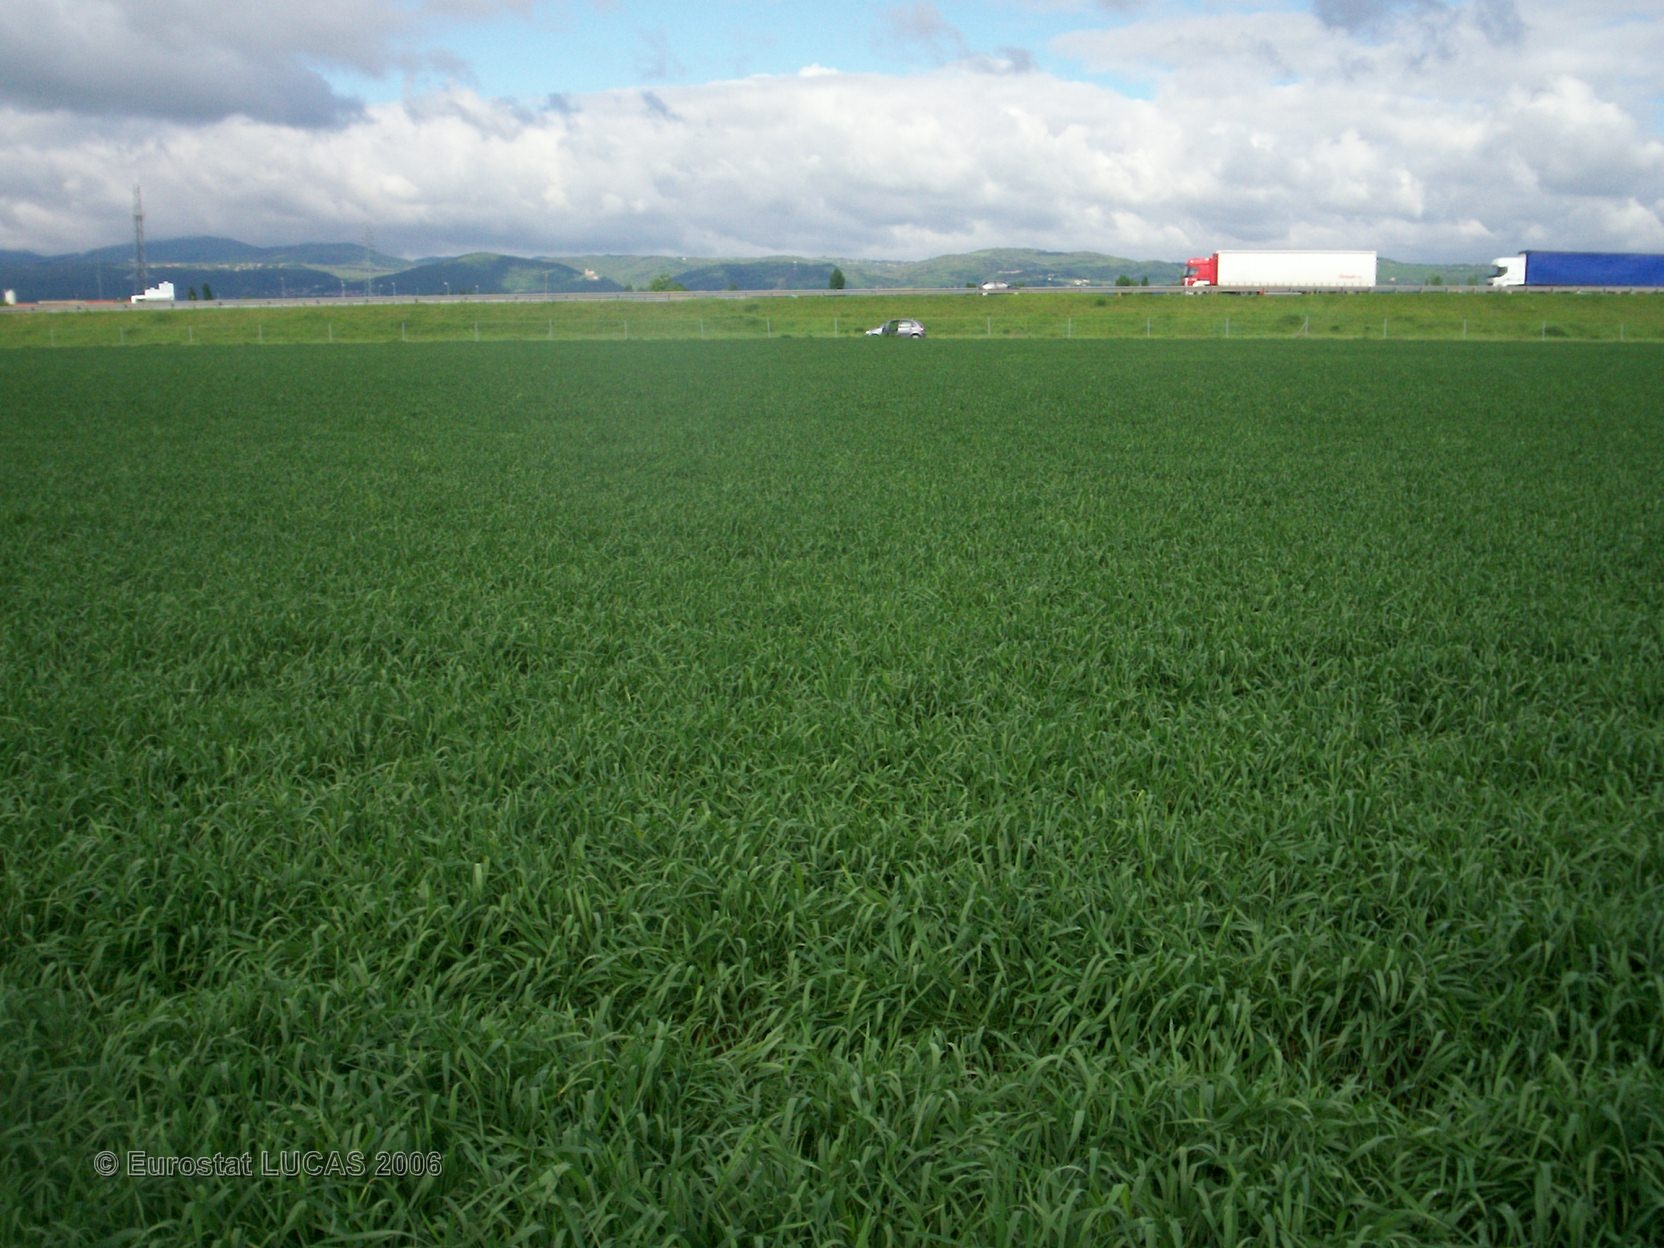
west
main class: Cropland
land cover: Barley
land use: Agriculture (excluding fallow land and kitchen gardens)
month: May
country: FR
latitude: 45.8969
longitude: 3.1557
